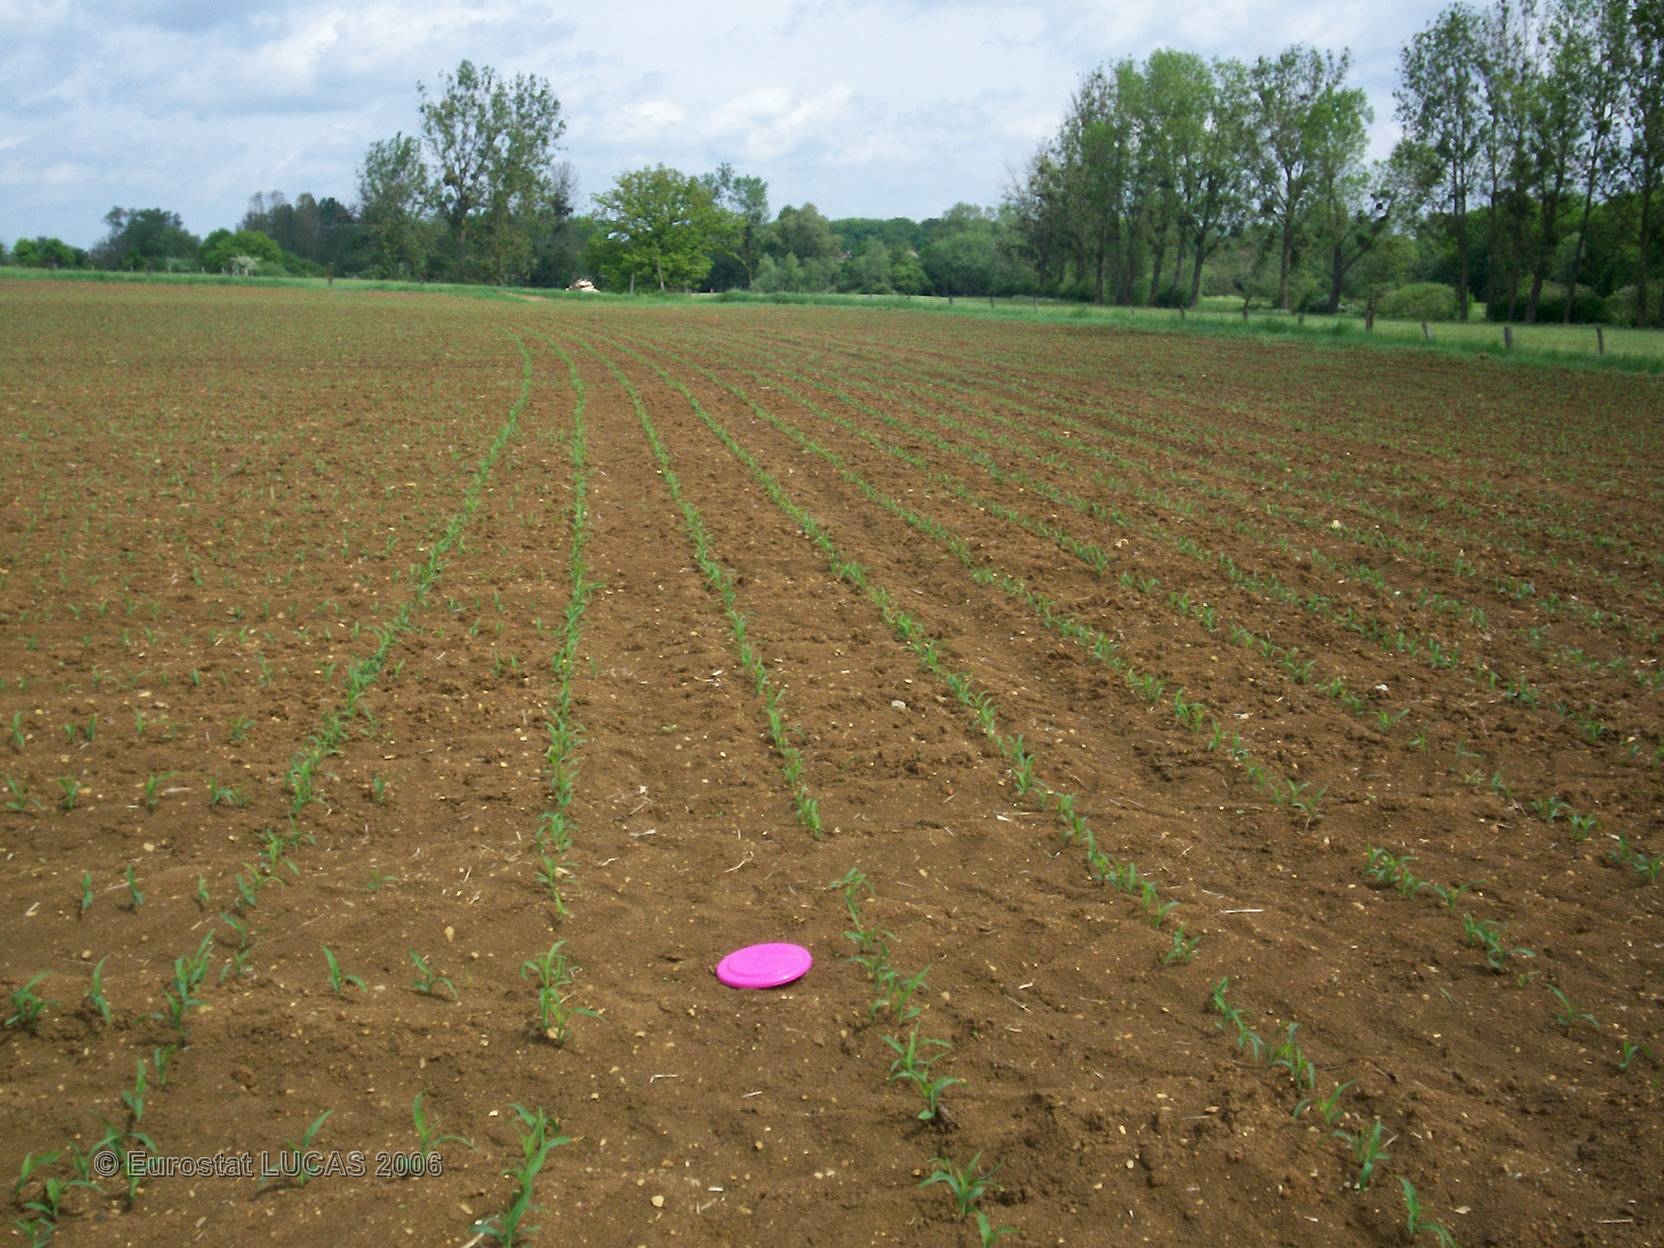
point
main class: Cropland
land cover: Maize
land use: Agriculture (excluding fallow land and kitchen gardens)
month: May
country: FR
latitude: 49.1371
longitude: 5.8736
